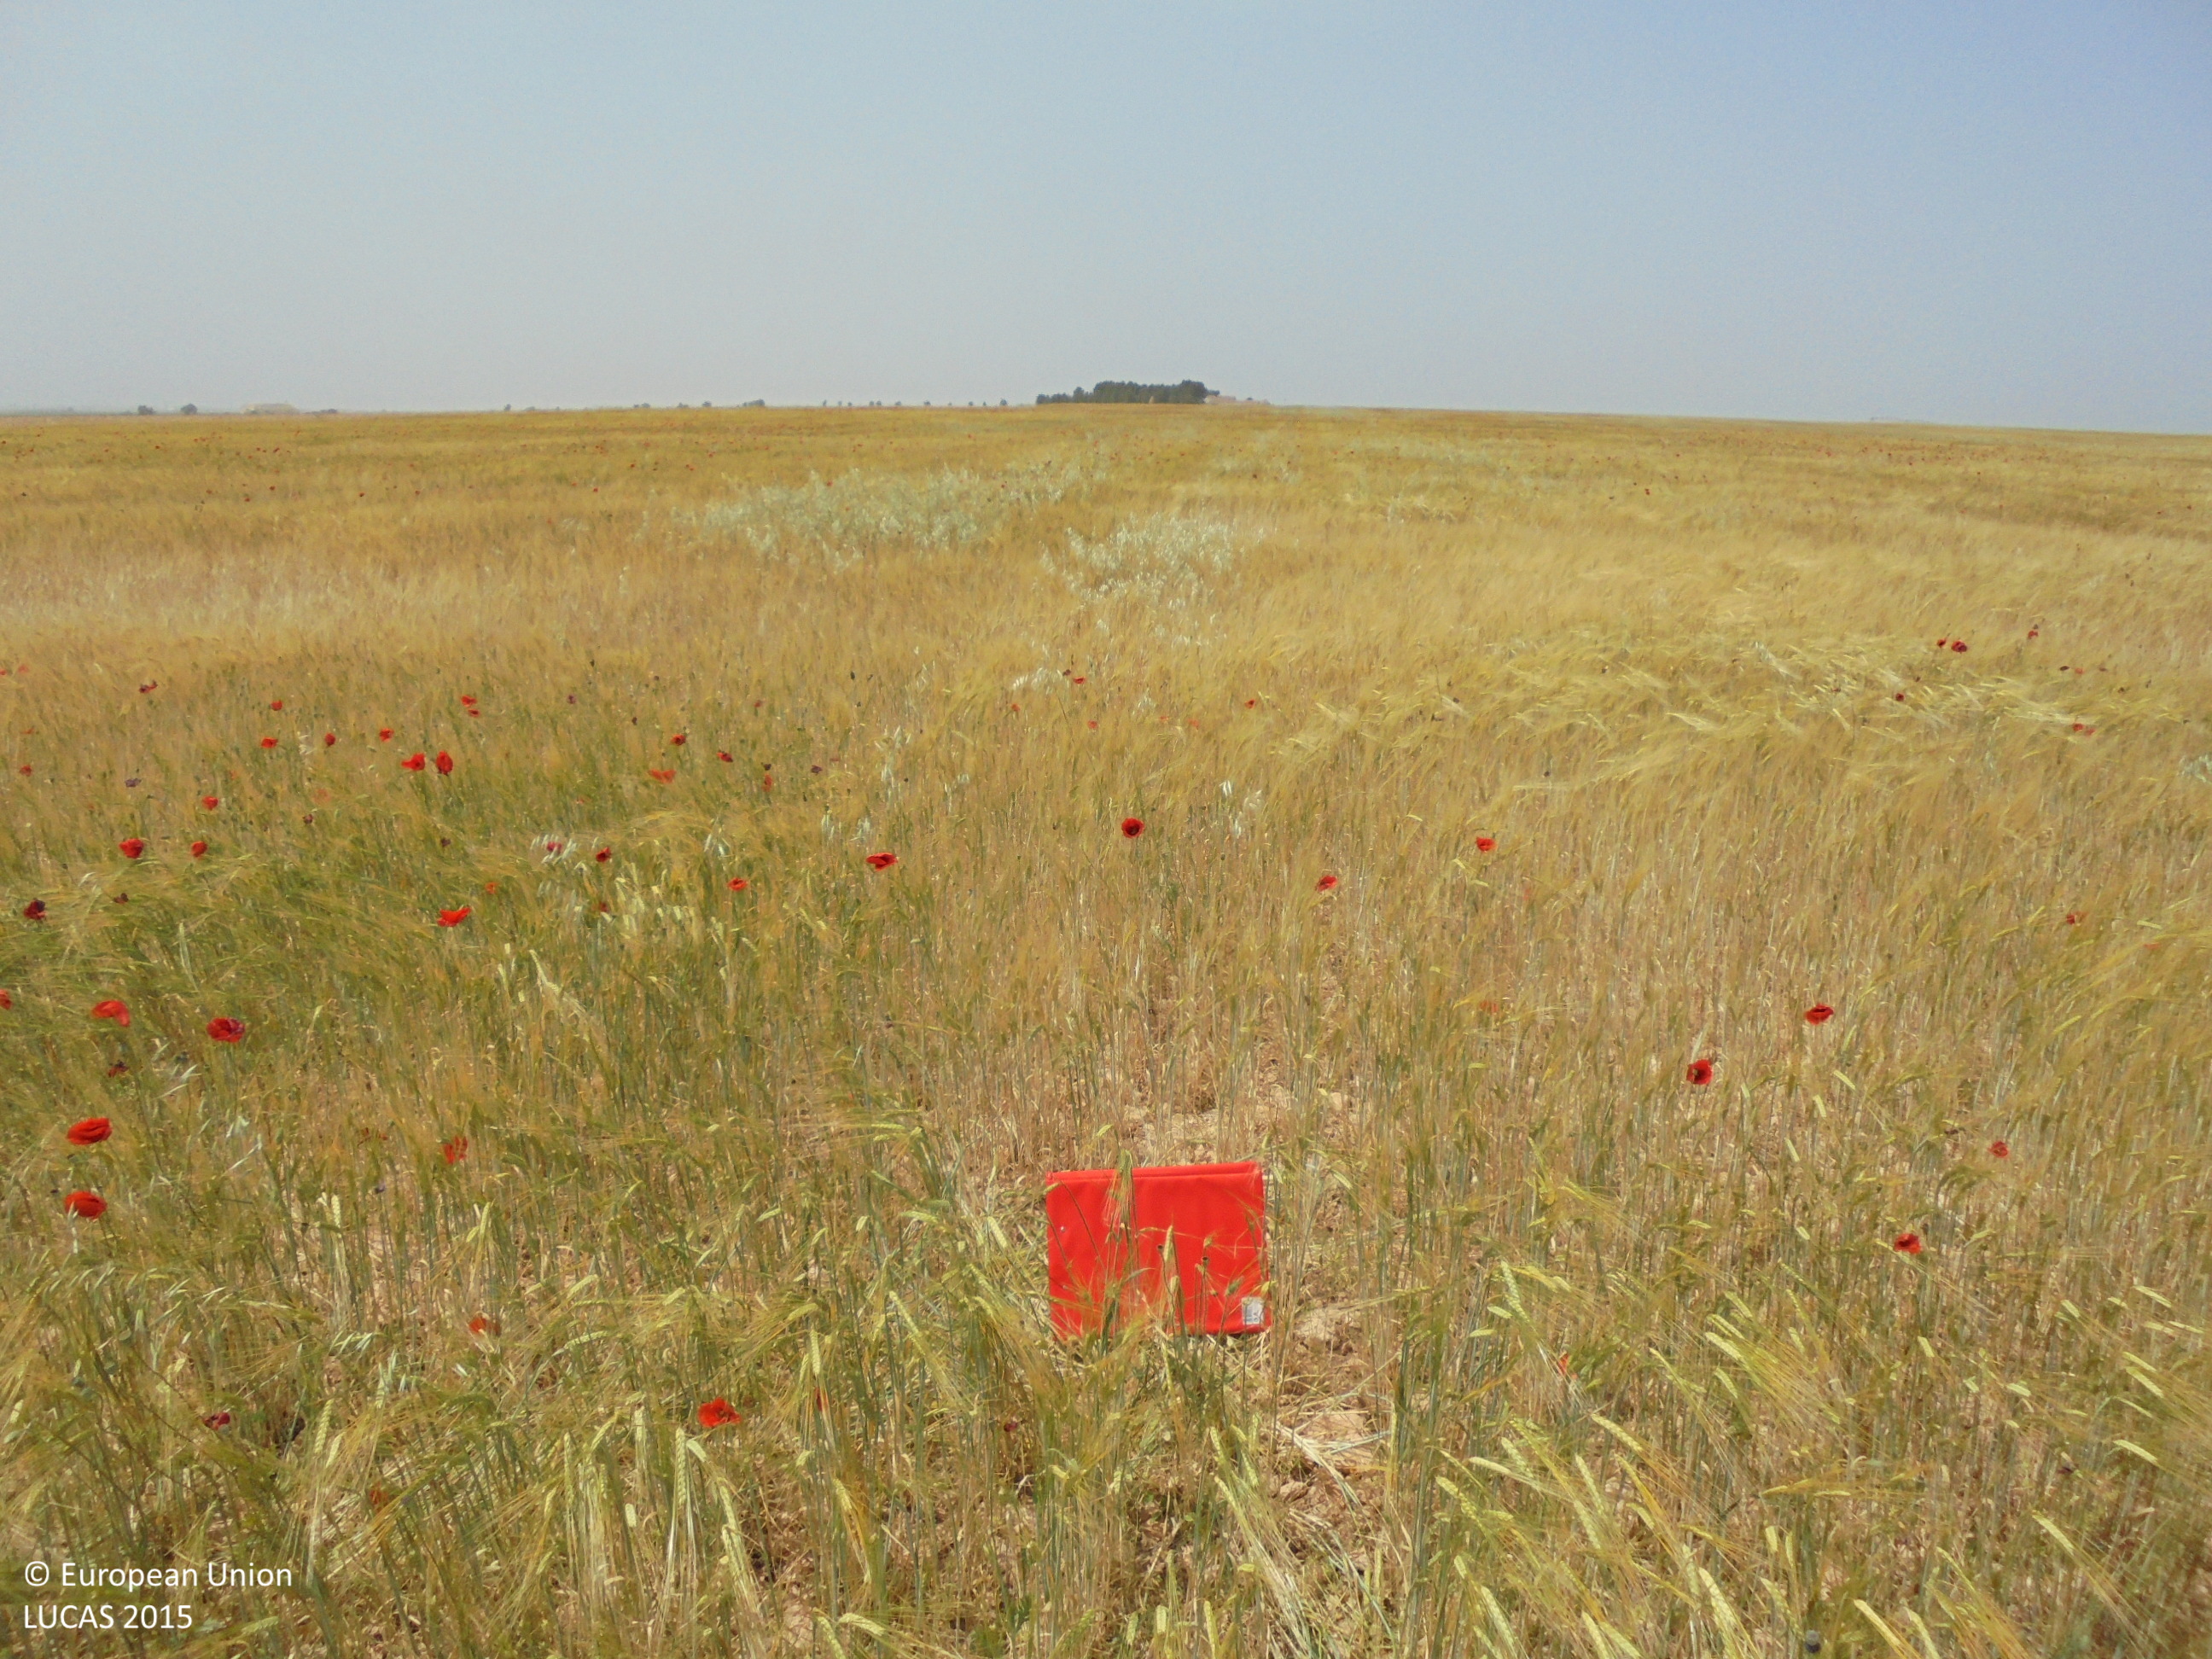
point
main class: Cropland
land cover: Barley
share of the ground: 50 - 75 %
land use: Agriculture (excluding fallow land and kitchen gardens)
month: May
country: ES
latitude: 39.1061
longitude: -1.7151
